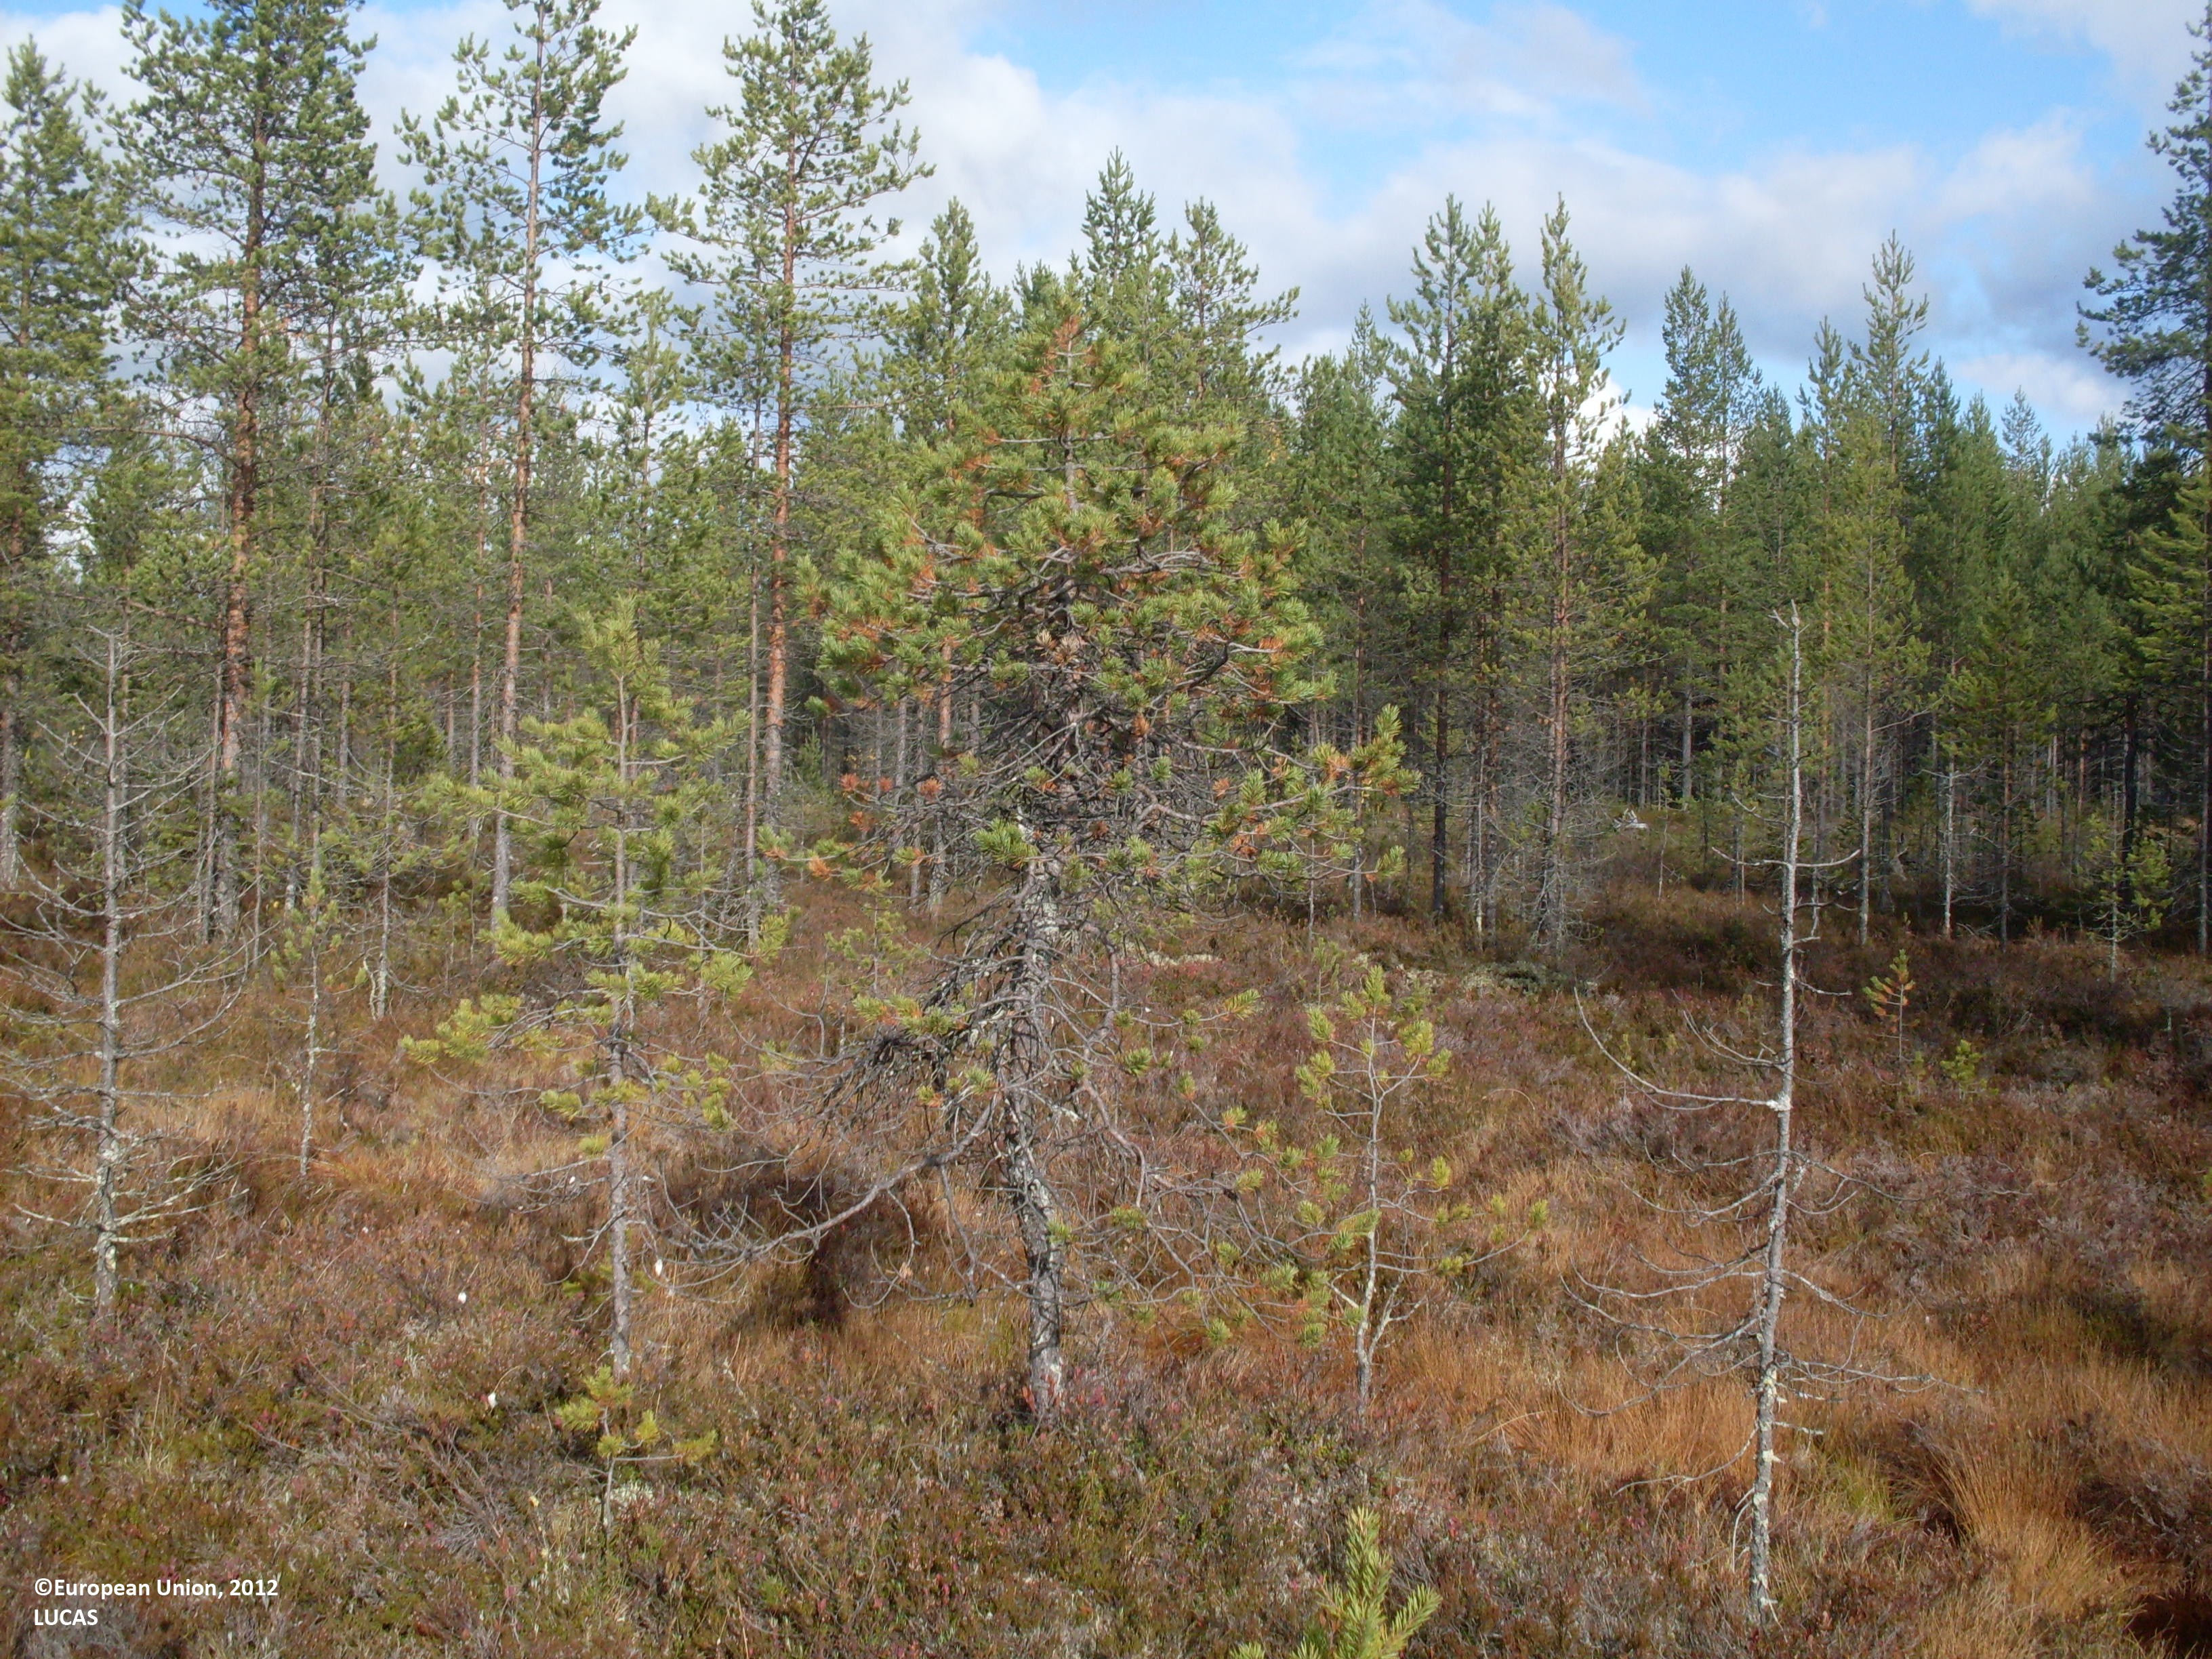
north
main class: Woodland
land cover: Pine dominated coniferous woodland
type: boreal forest
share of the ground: 10 - 25 %
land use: Forestry
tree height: > 5 m
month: September
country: FI
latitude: 64.7906
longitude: 29.4174
